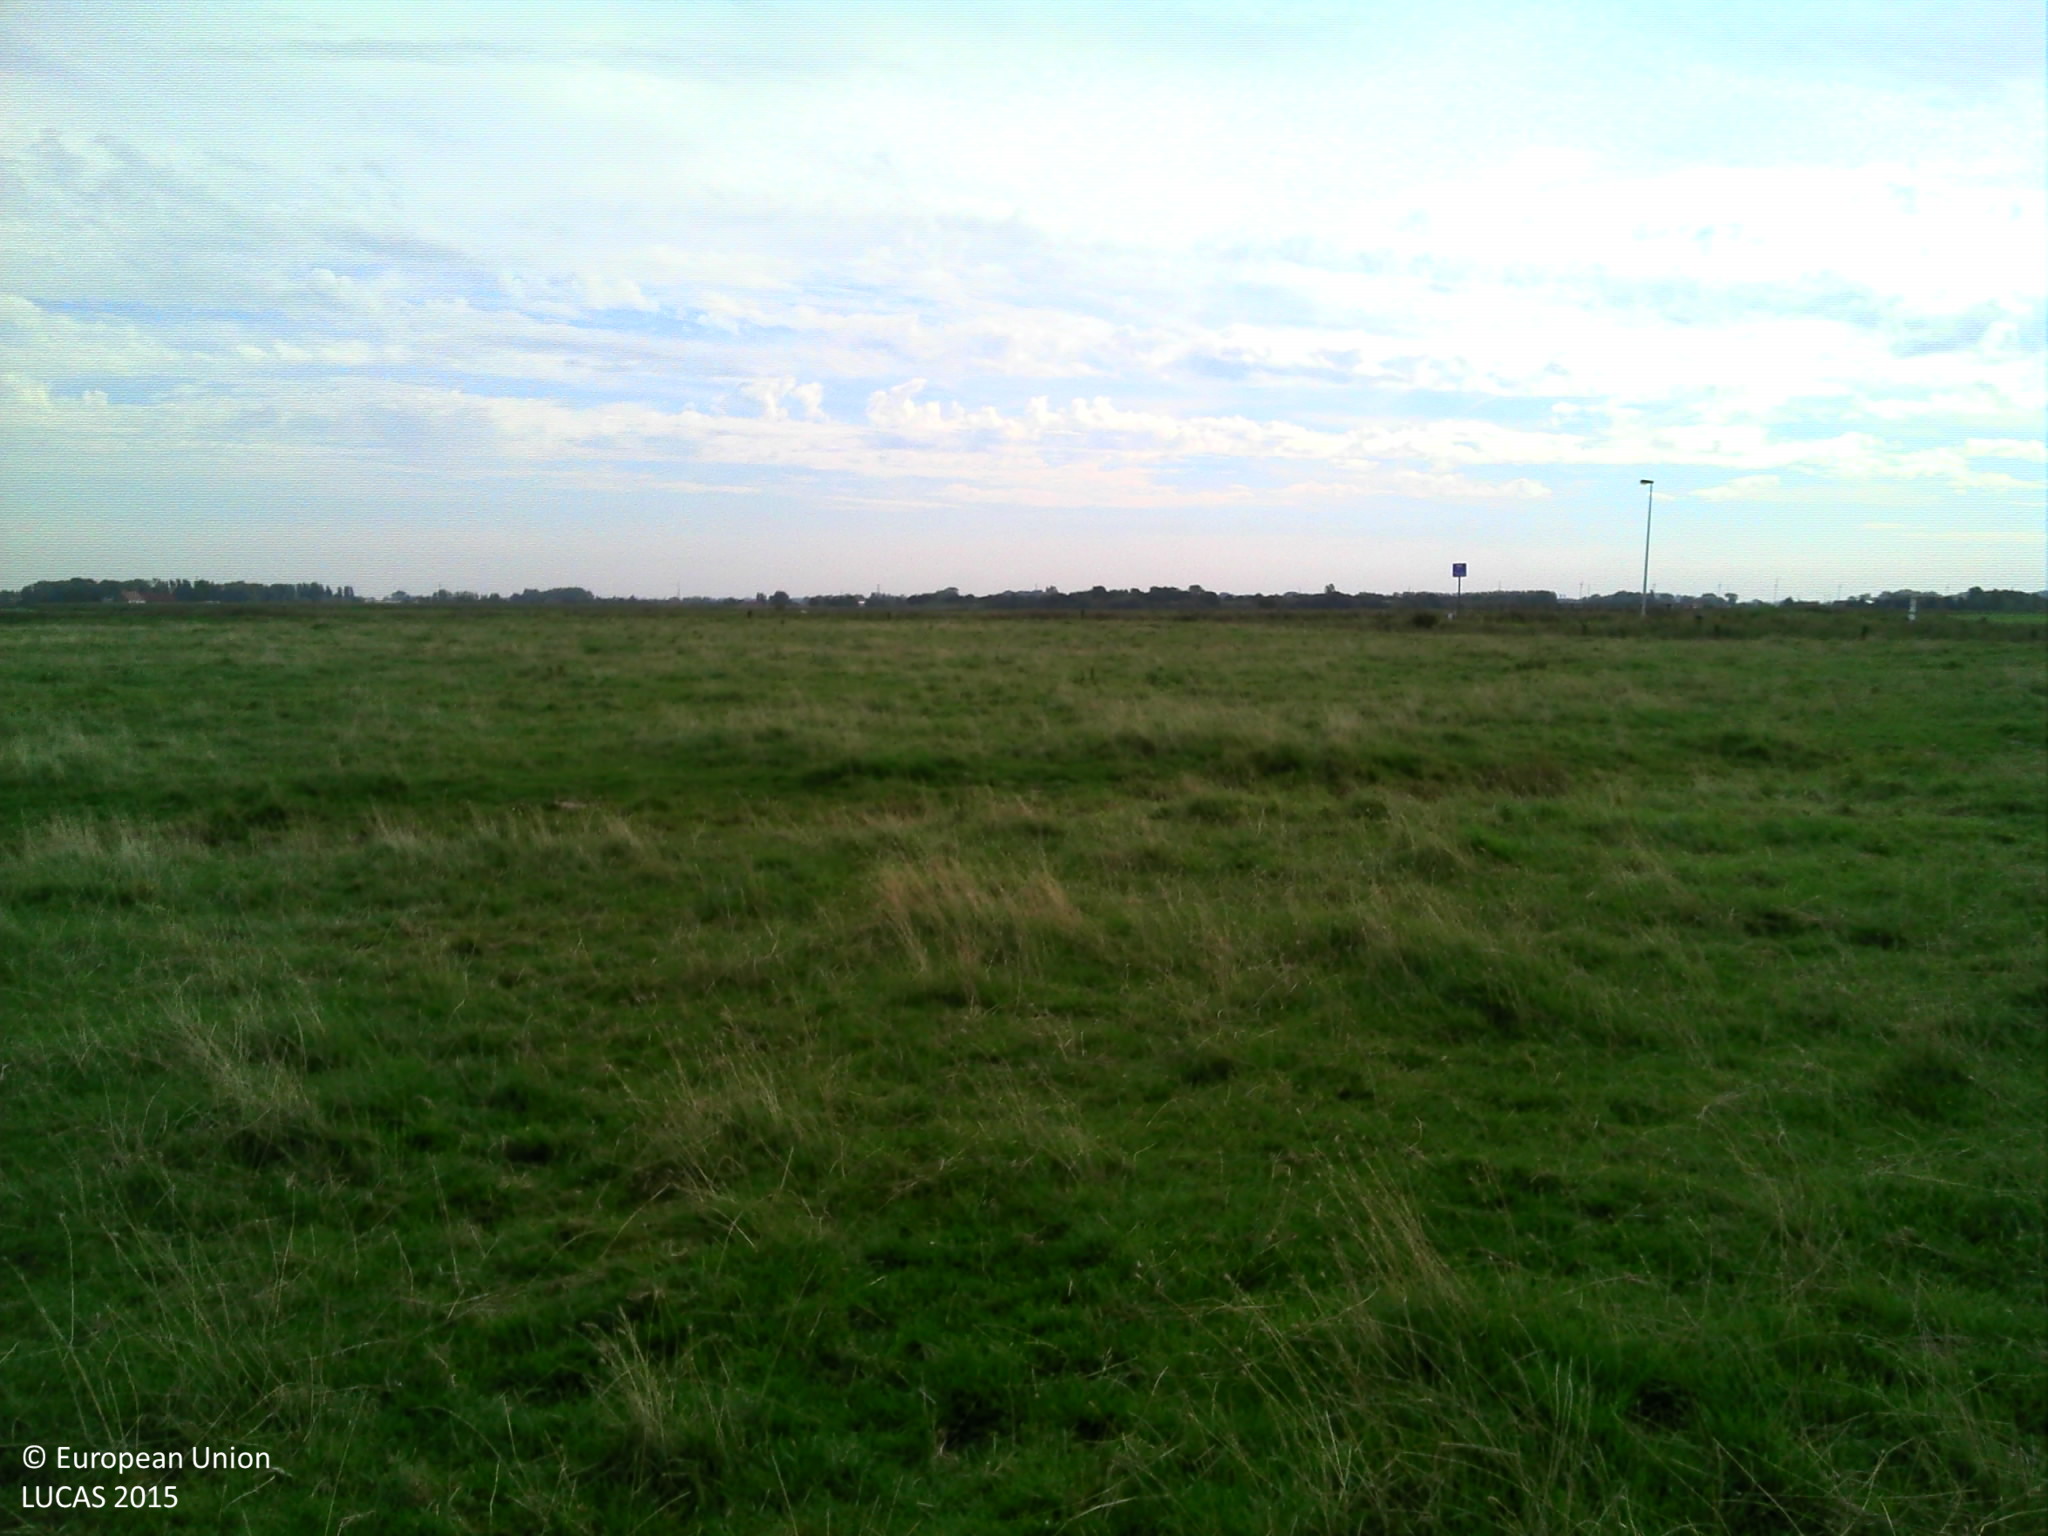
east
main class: Grassland
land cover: Grassland without tree/shrub cover
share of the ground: > 75 %
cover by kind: herbaceous plants 100 %
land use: Agriculture (excluding fallow land and kitchen gardens)
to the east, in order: Grassland without tree/shrub cover; Ditches and canals; Grassland without tree/shrub cover; Ditches and canals; Grassland without tree/shrub cover; Fences; Inland fresh water bodies; Grass margins; Paved roads, cycling and walking lanes; Grass margins; Ditches and canals; Fences; Grassland without tree/shrub cover
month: September
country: BE
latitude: 51.2938
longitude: 3.1213
